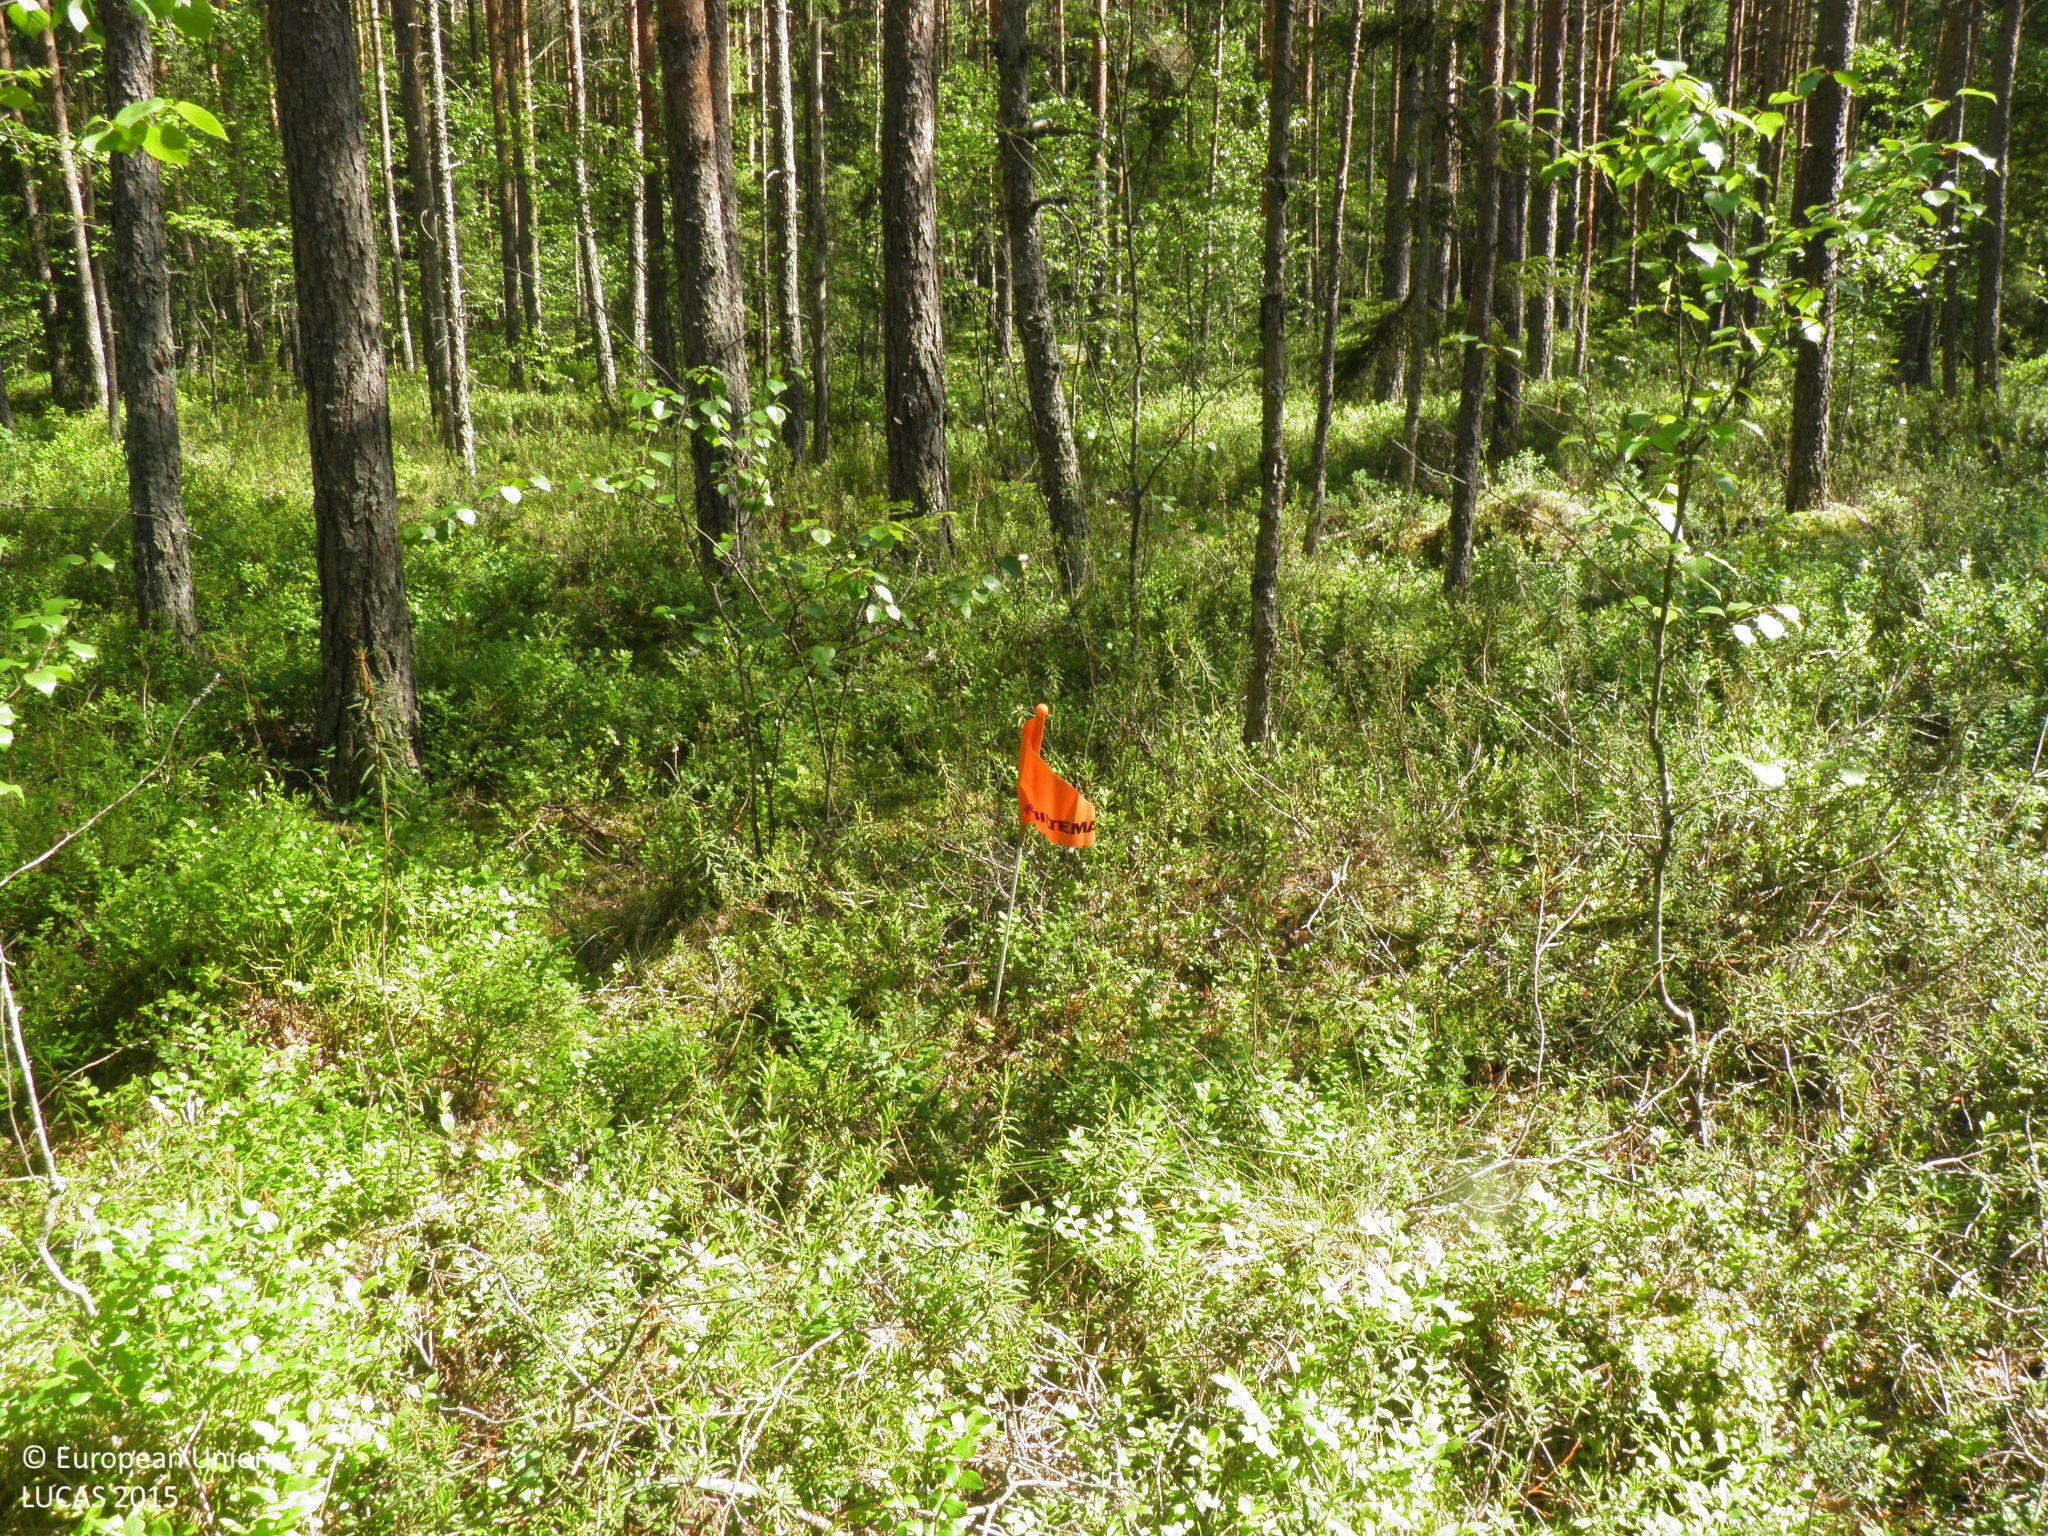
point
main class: Woodland
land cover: Pine dominated coniferous woodland
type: hemiboreal forest and nemoral coniferous forest and mixed broadleaved-coniferous forest
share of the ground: > 75 %
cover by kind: coniferous forest trees 75 %, shrubs 15 %, lichens and mosses 10 %
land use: Forestry
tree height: > 5 m
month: June
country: FI
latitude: 60.4726
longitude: 22.7898
